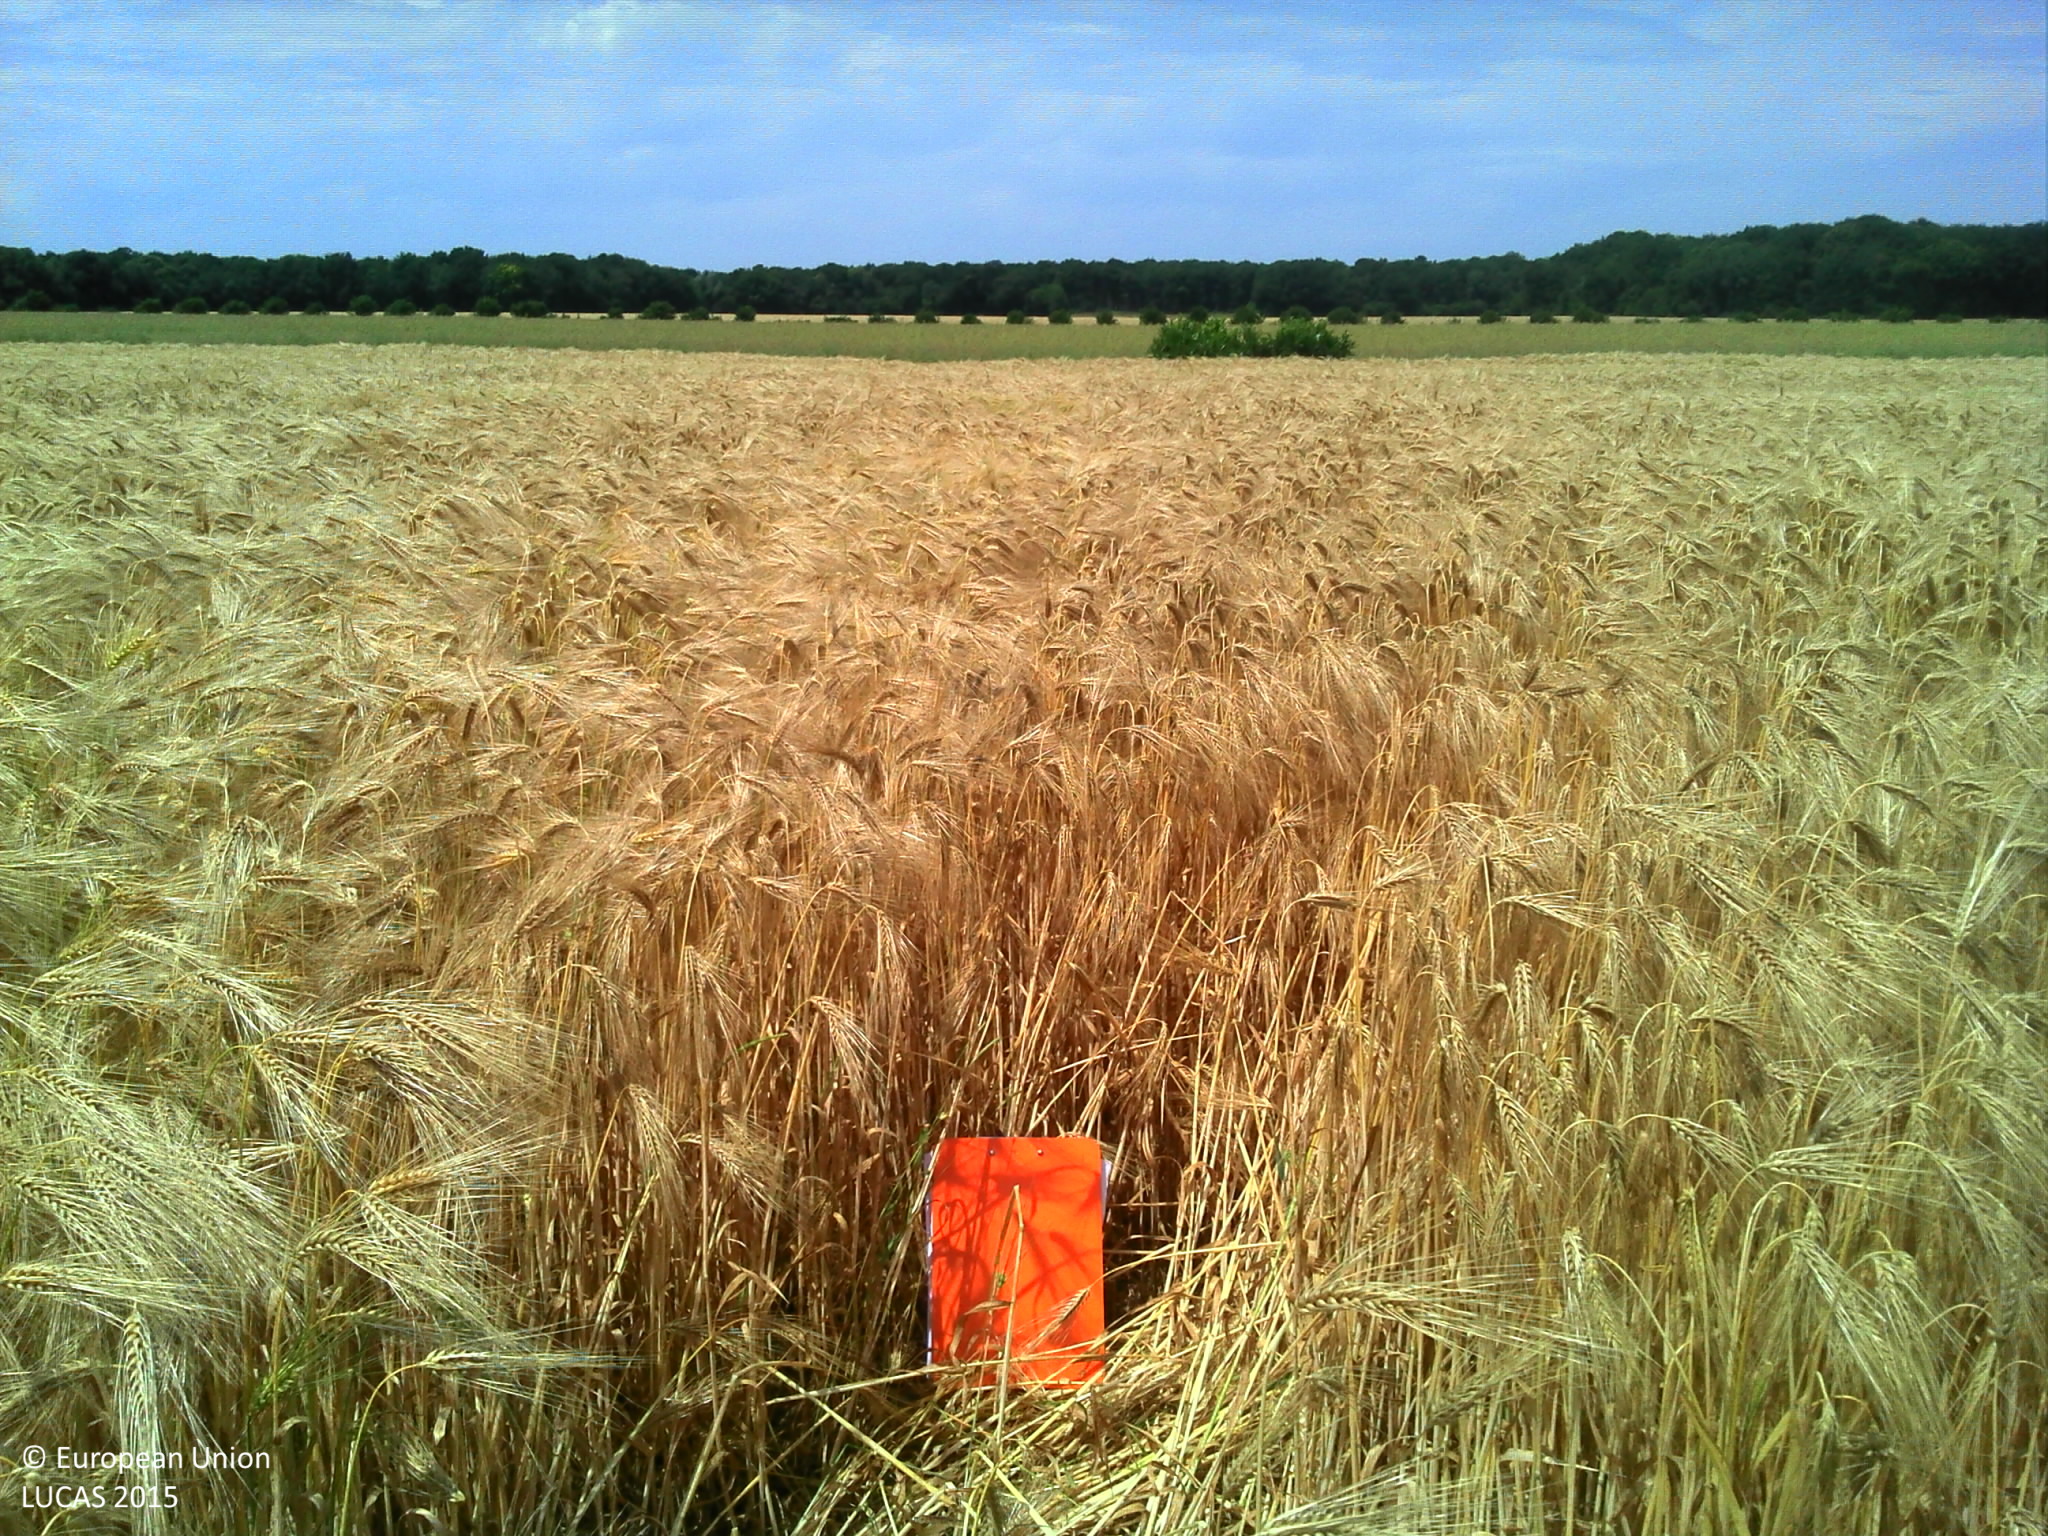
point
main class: Cropland
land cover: Barley
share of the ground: > 75 %
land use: Agriculture (excluding fallow land and kitchen gardens)
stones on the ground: 10 - 25 %
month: June
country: FR
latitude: 49.1017
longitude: 1.2002
